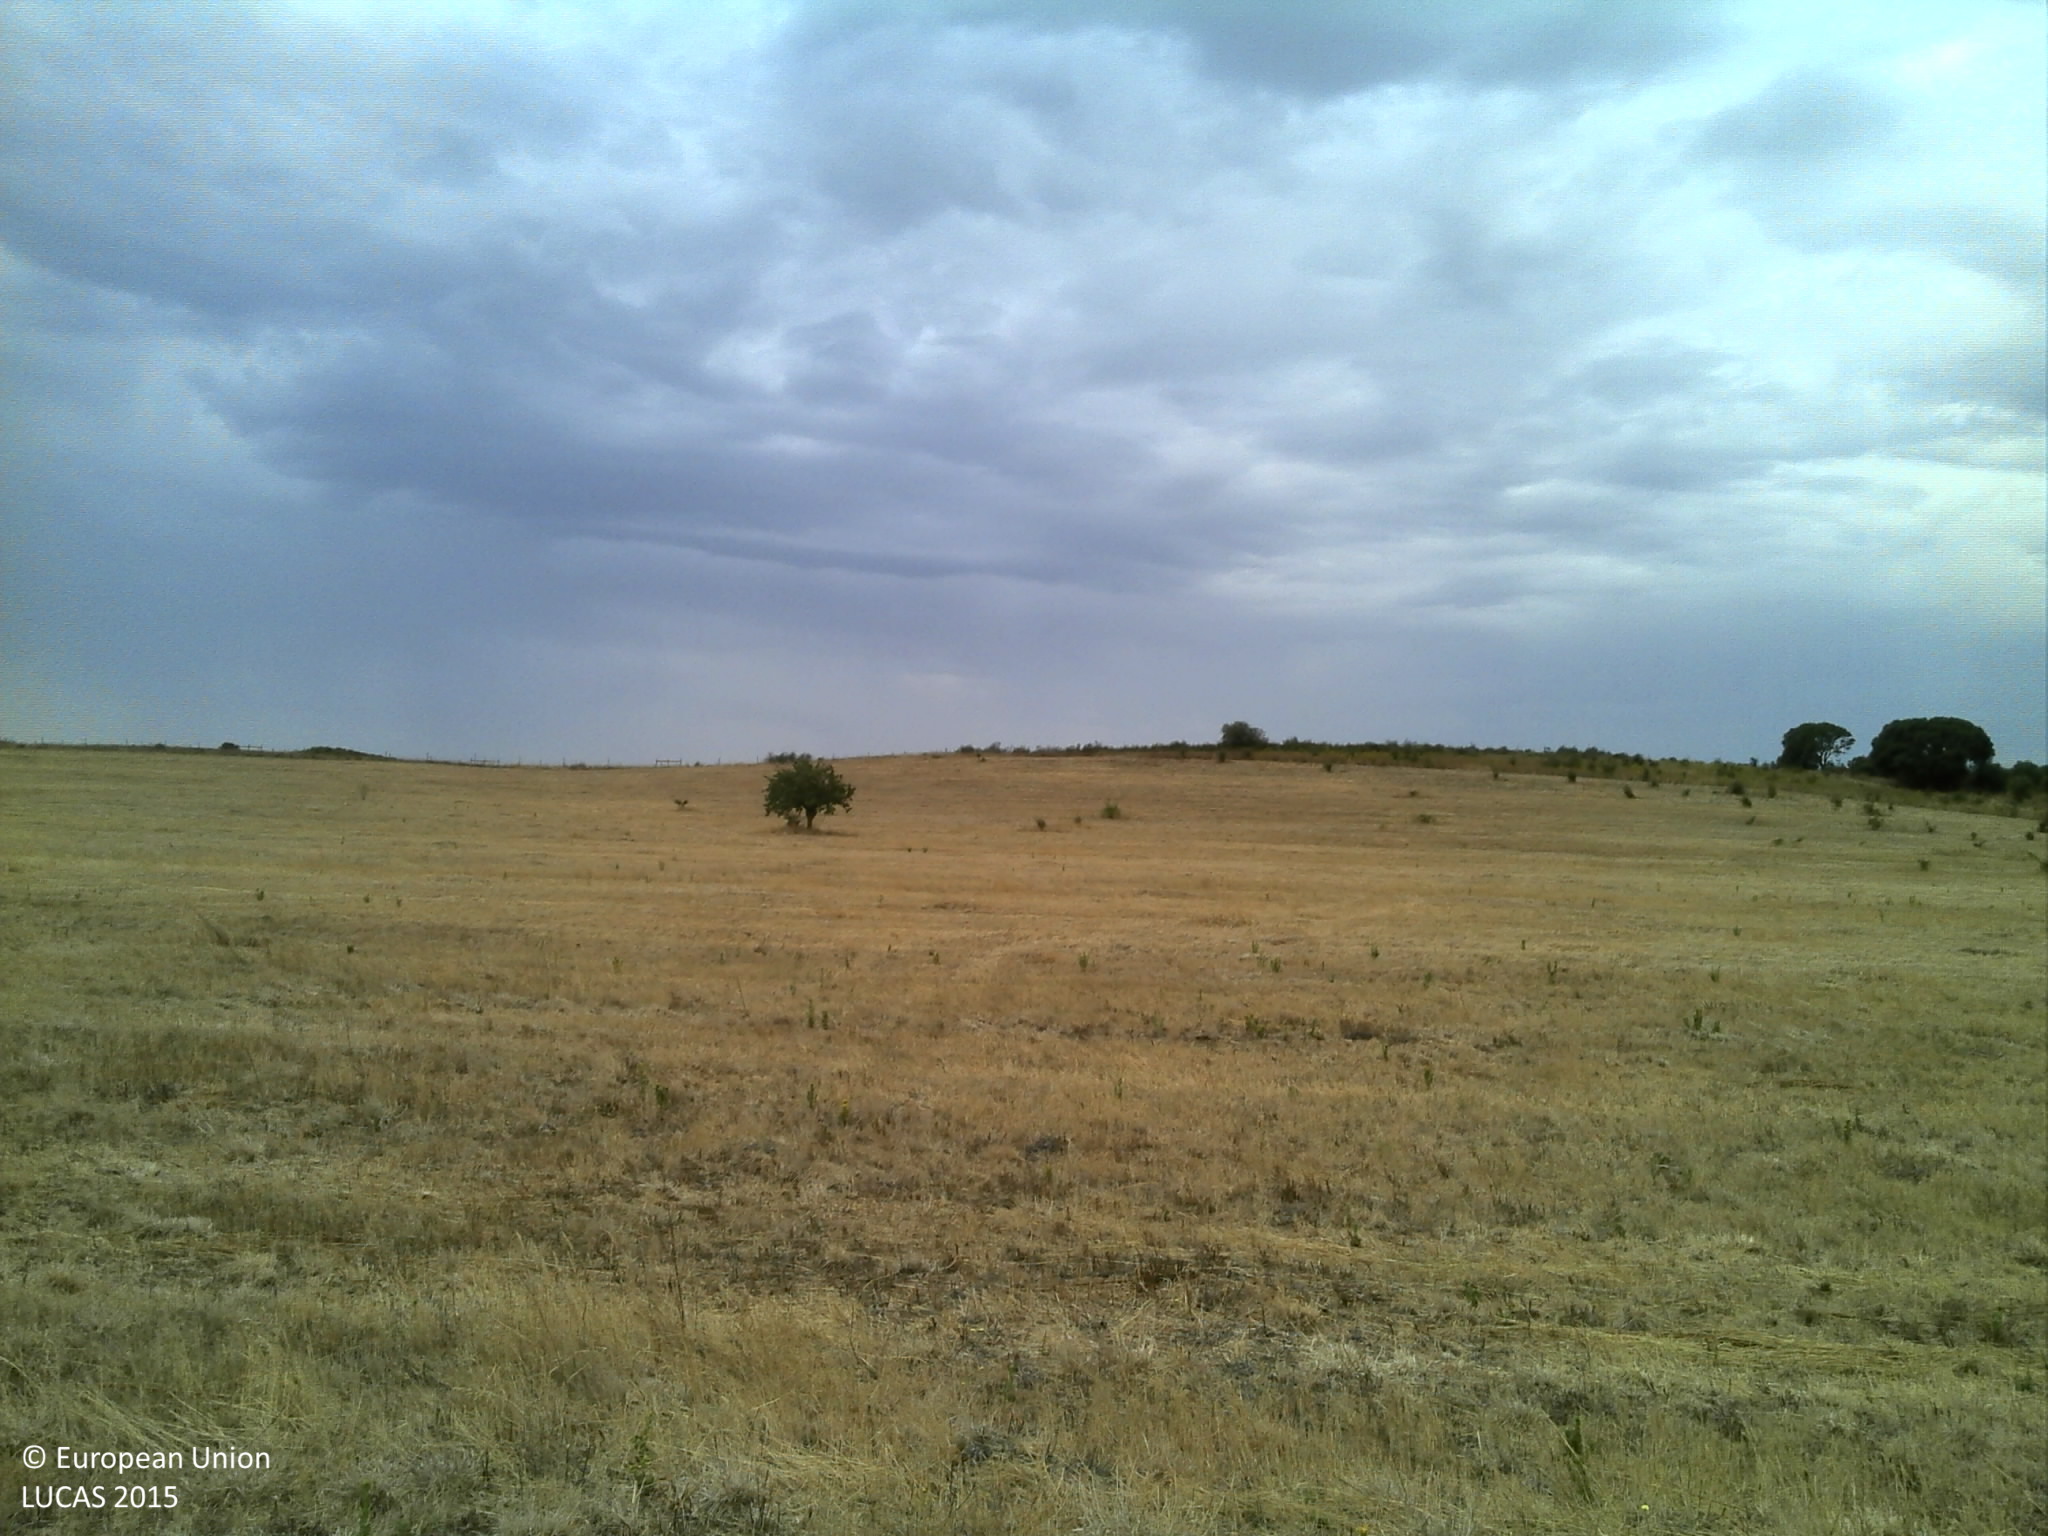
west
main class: Grassland
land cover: Grassland without tree/shrub cover
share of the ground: 25 - 50 %
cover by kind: unconsolidated bare surface 60 %, herbaceous plants 40 %
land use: Agriculture (excluding fallow land and kitchen gardens)
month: July
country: PT
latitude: 38.8432
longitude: -7.4187
